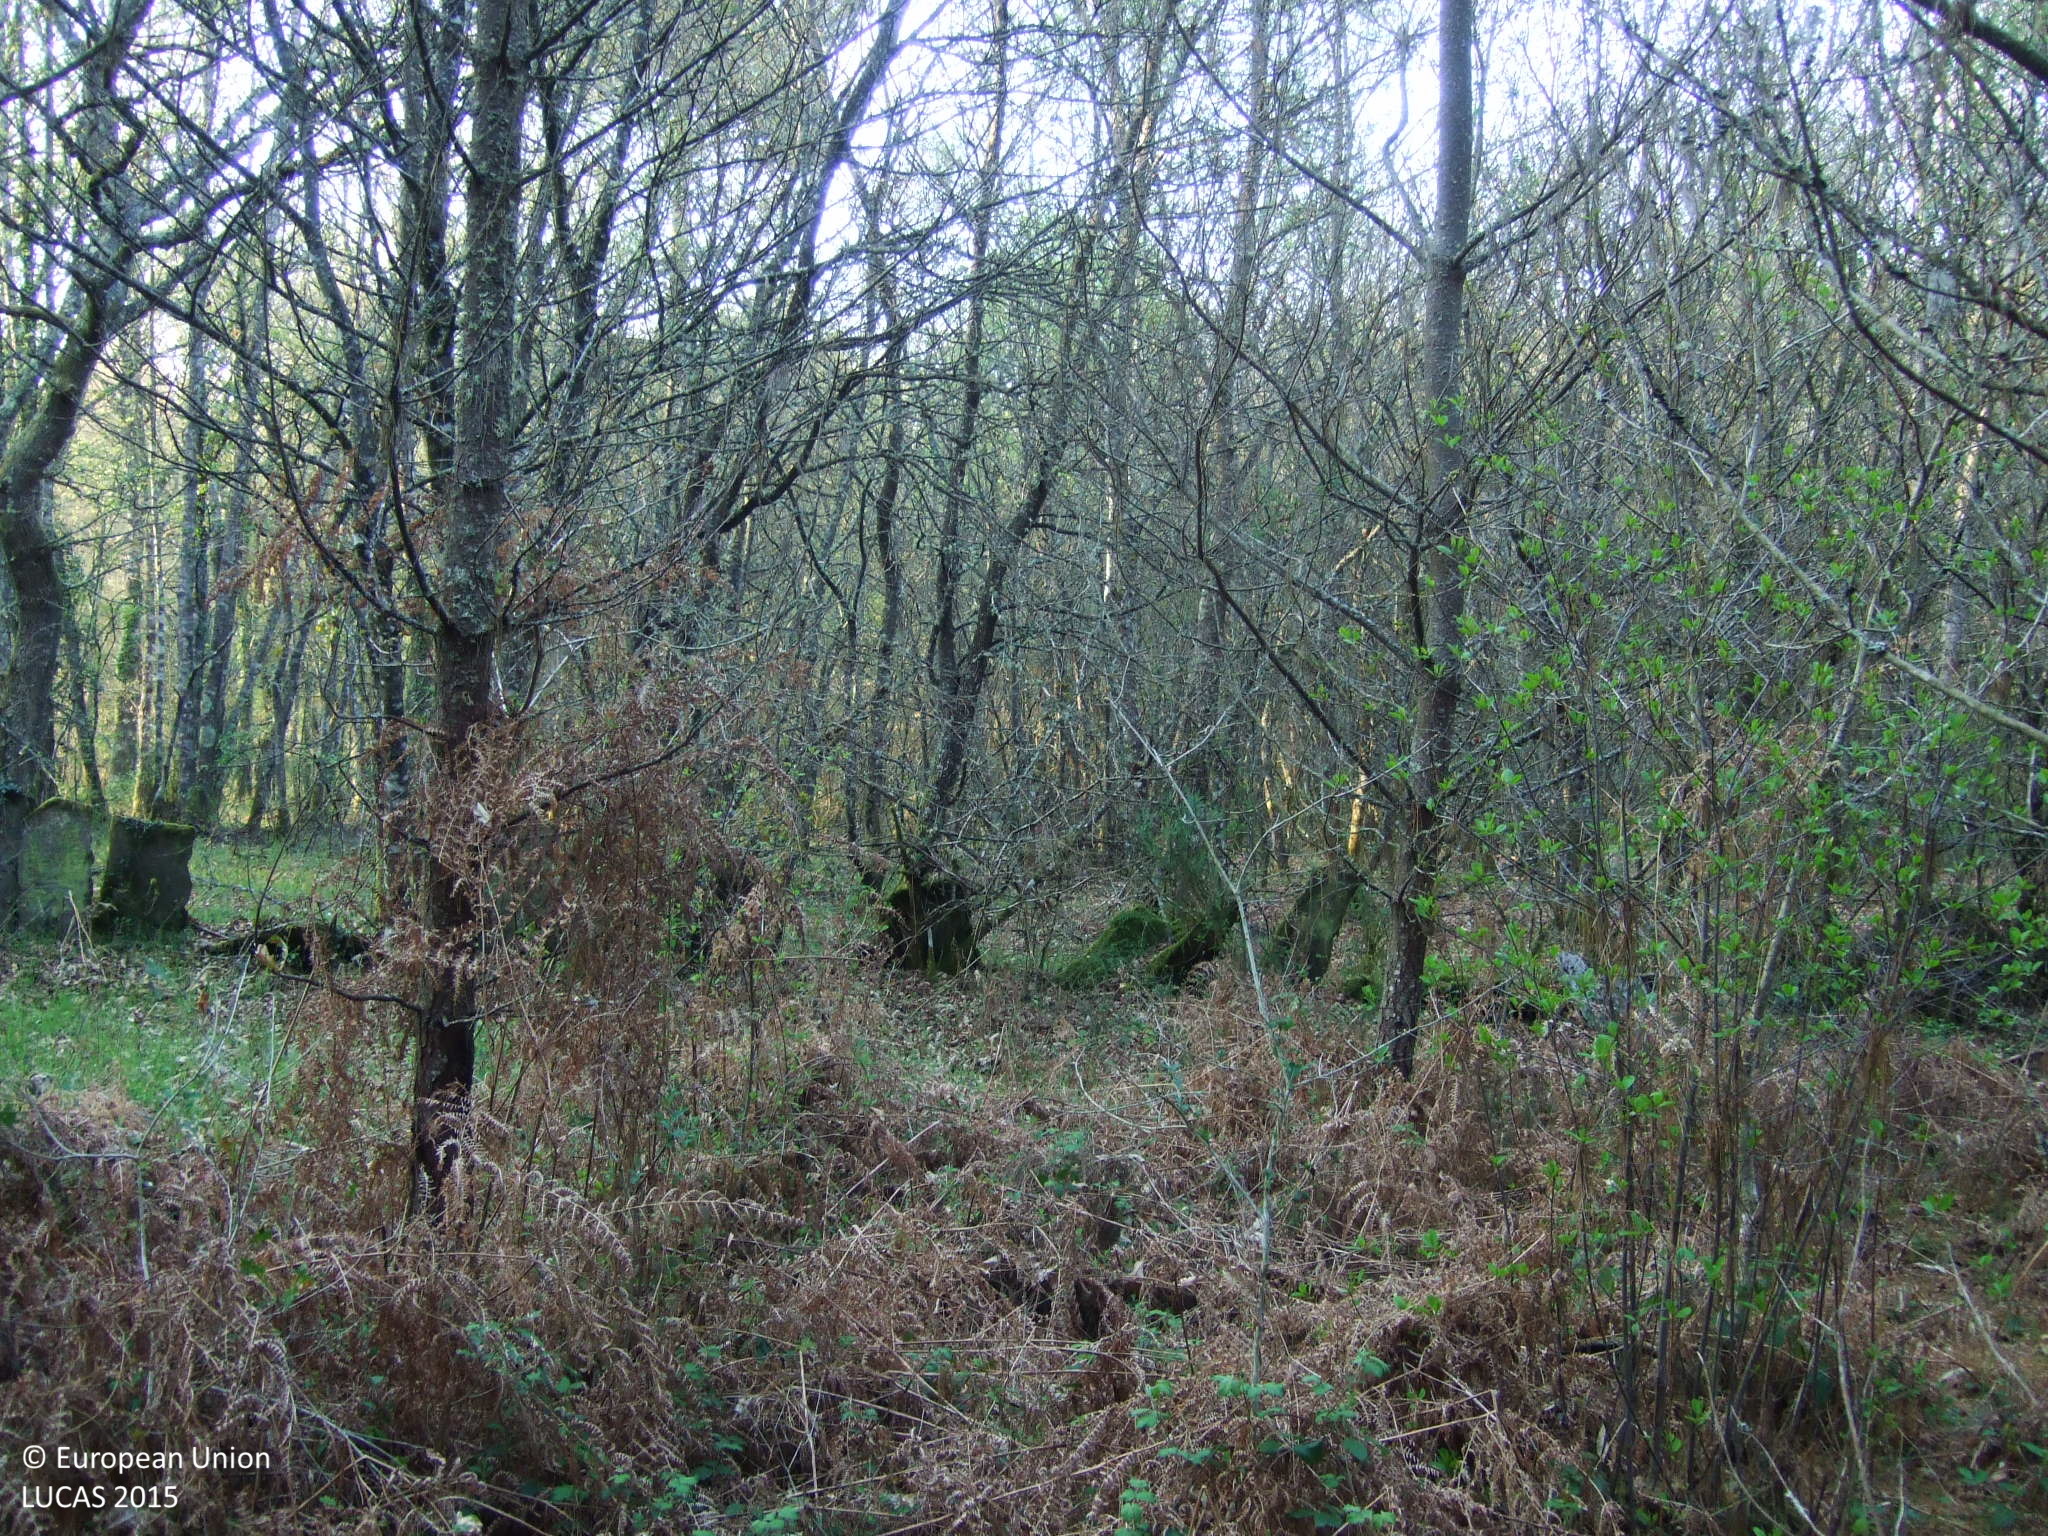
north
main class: Woodland
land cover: Pine dominated coniferous woodland
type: exotic forest
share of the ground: 25 - 50 %
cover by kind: coniferous forest trees 50 %, herbaceous plants 30 %, shrubs 20 %
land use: Forestry
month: April
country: ES
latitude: 43.0705
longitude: -7.6040
